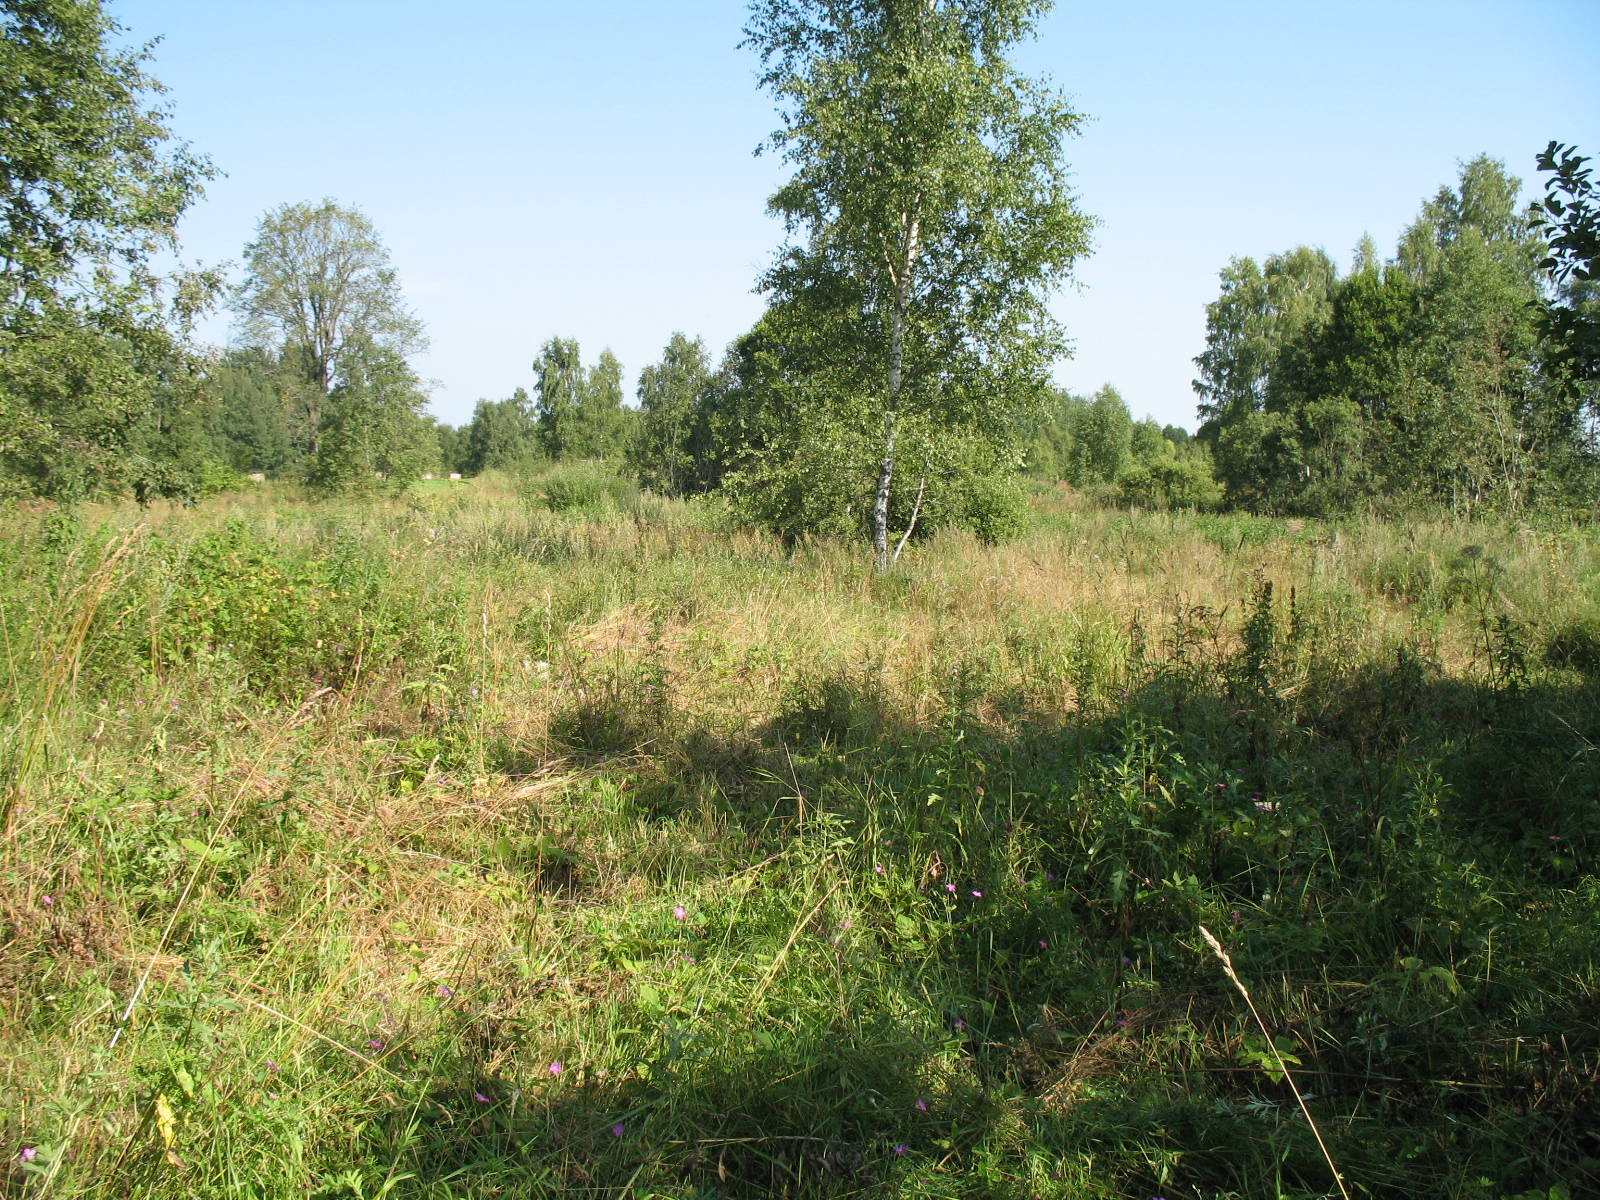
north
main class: Grassland
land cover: Spontaneously vegetated surfaces
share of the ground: > 75 %
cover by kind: herbaceous plants 95 %, shrubs 5 %
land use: Semi-natural and natural areas not in use
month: August
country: LV
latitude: 56.2369
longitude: 25.4305
